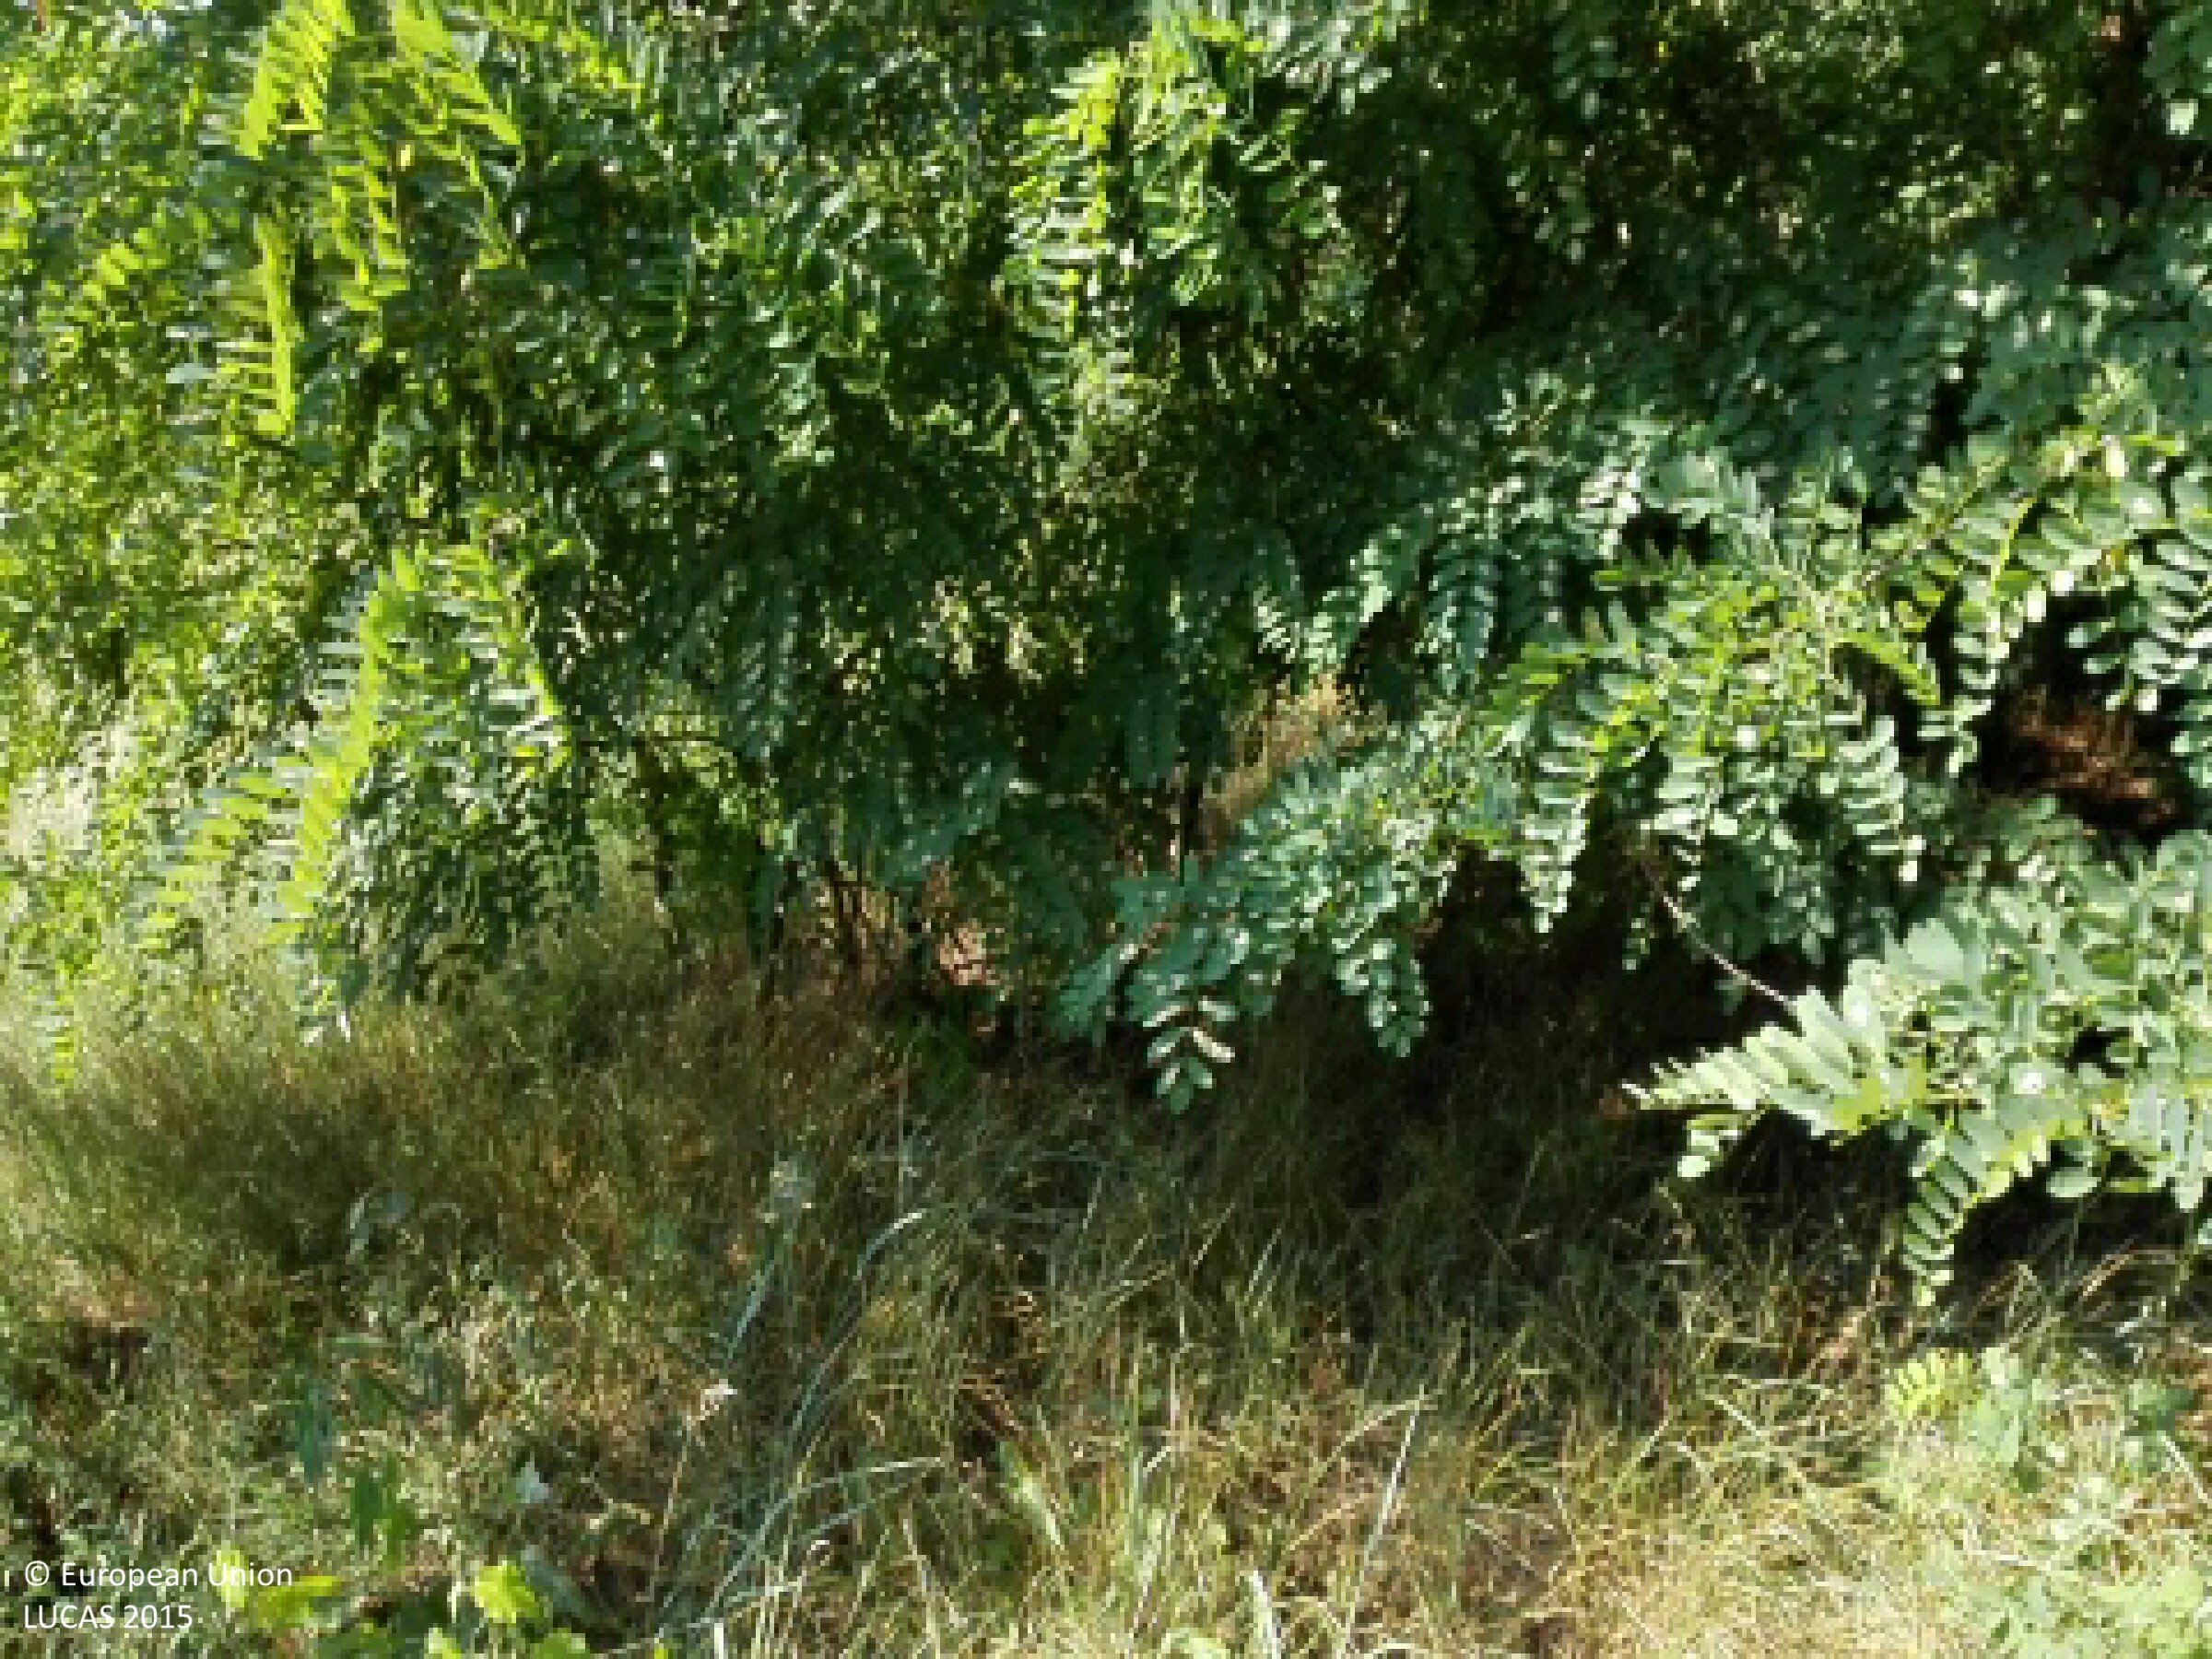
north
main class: Woodland
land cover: Broadleaved woodland
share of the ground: > 75 %
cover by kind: broadleaved forest trees 40 %, shrubs 30 %, herbaceous plants 30 %
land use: Semi-natural and natural areas not in use
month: July
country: HU
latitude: 47.6943
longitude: 21.6512
